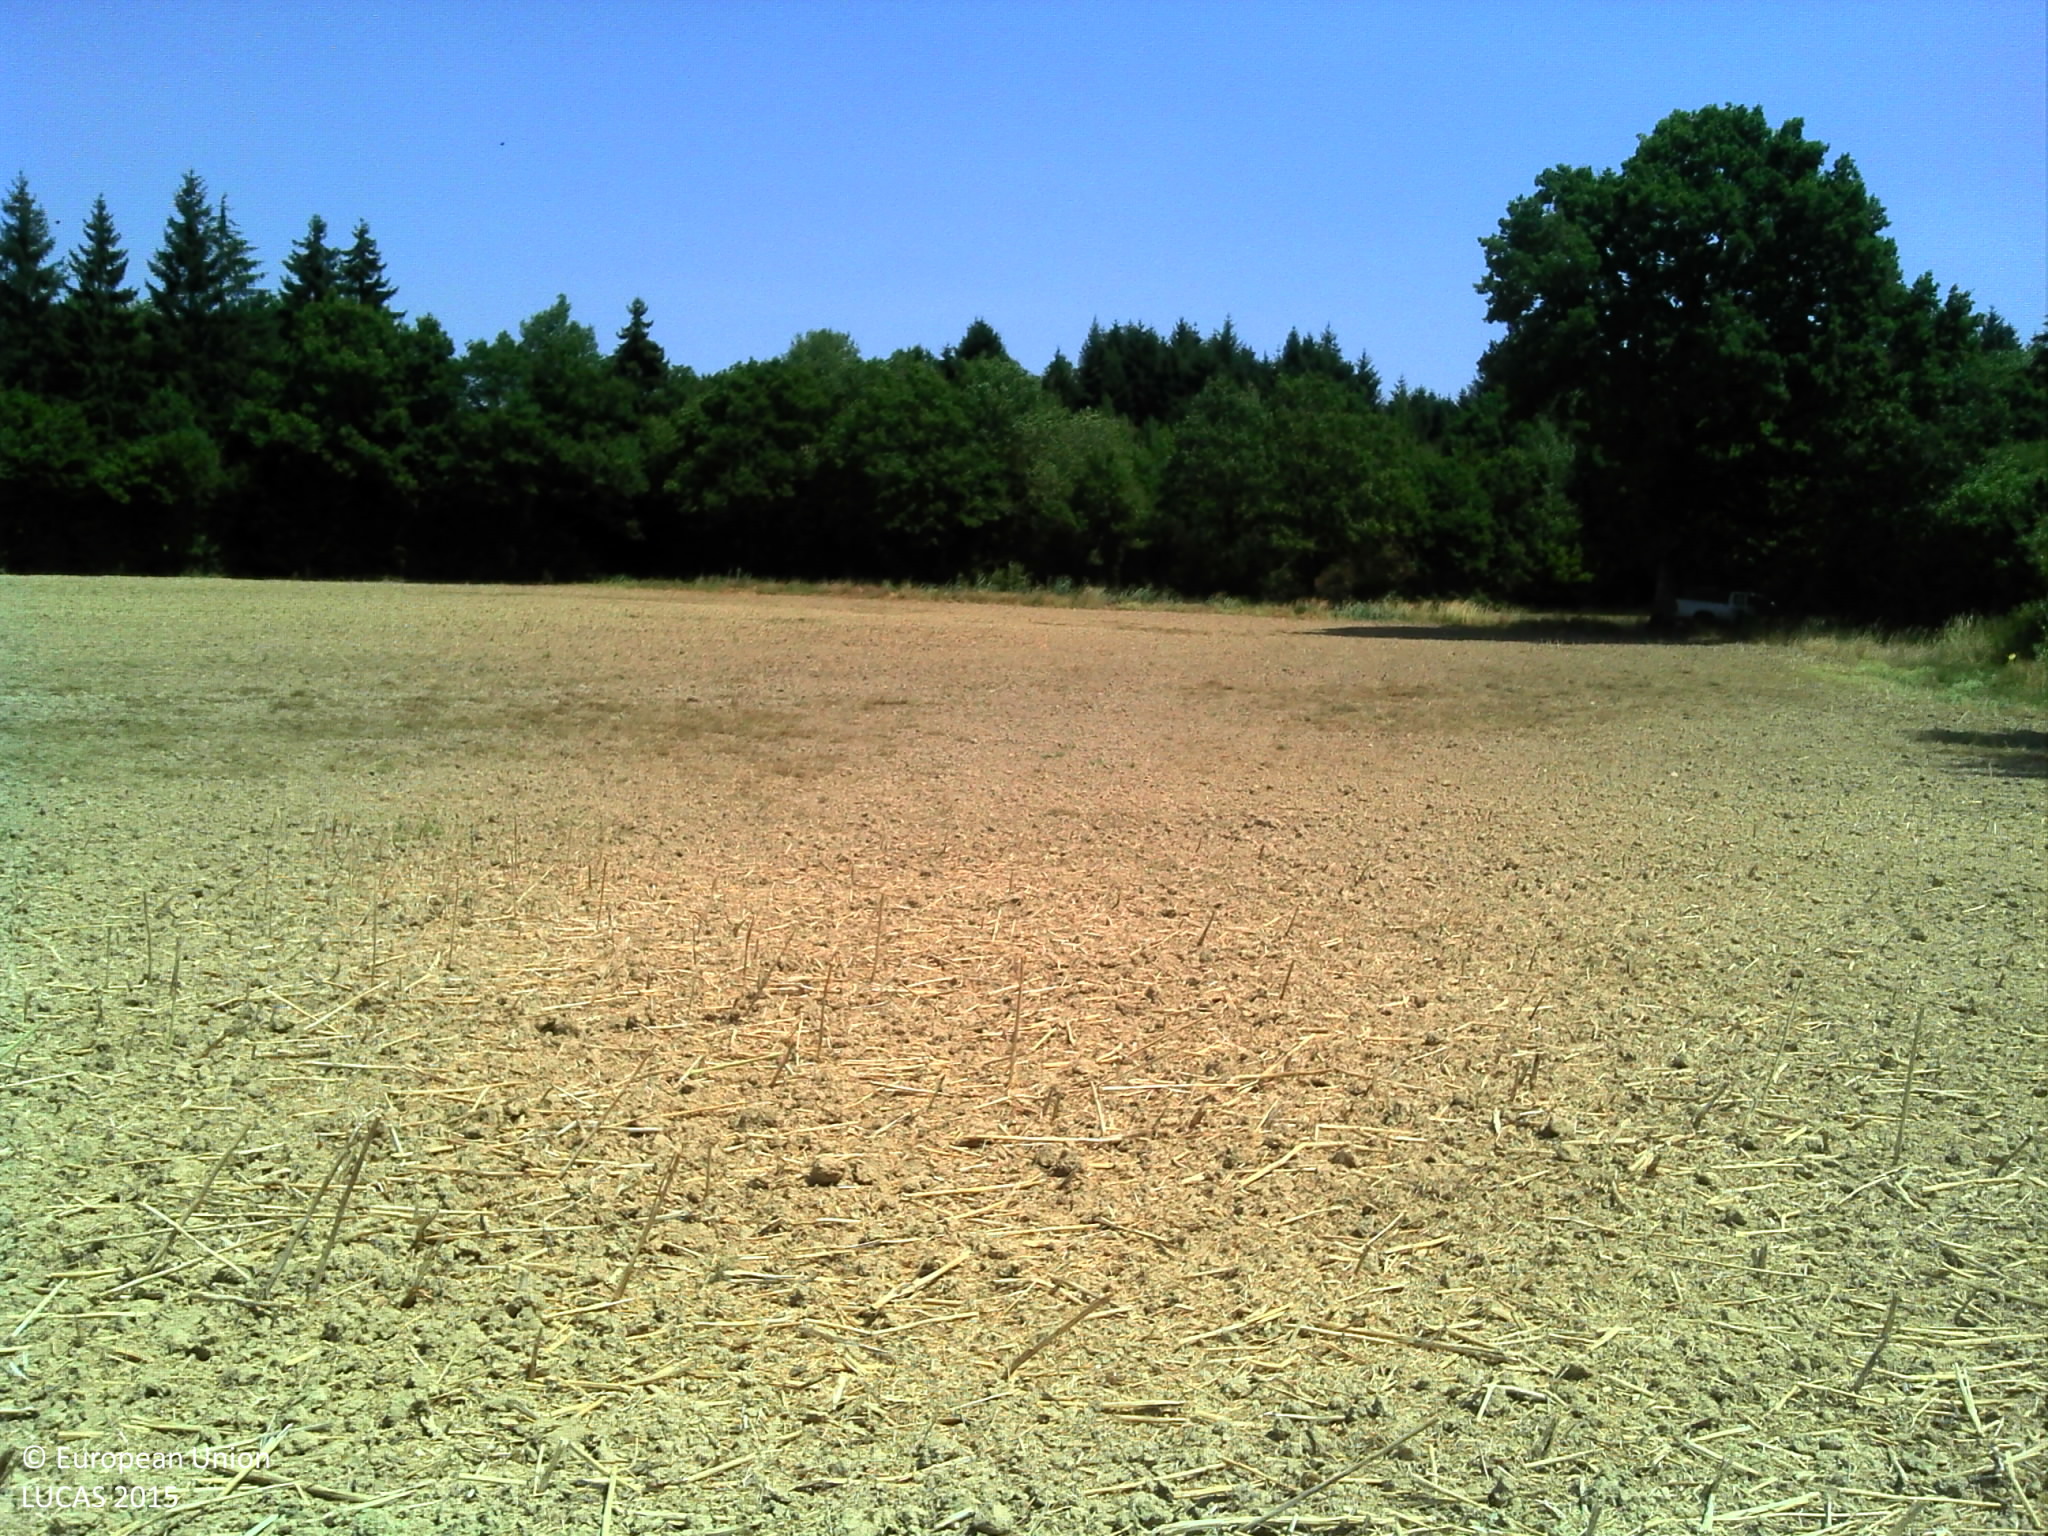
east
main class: Cropland
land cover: Rape and turnip rape
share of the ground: > 75 %
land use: Agriculture (excluding fallow land and kitchen gardens)
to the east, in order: Rape and turnip rape; Ditches and canals; Broadleaved woodland; Grassland without tree/shrub cover; Ditches and canals; Broadleaved woodland; Pine dominated coniferous woodland
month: July
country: FR
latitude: 47.0095
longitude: 3.6184
